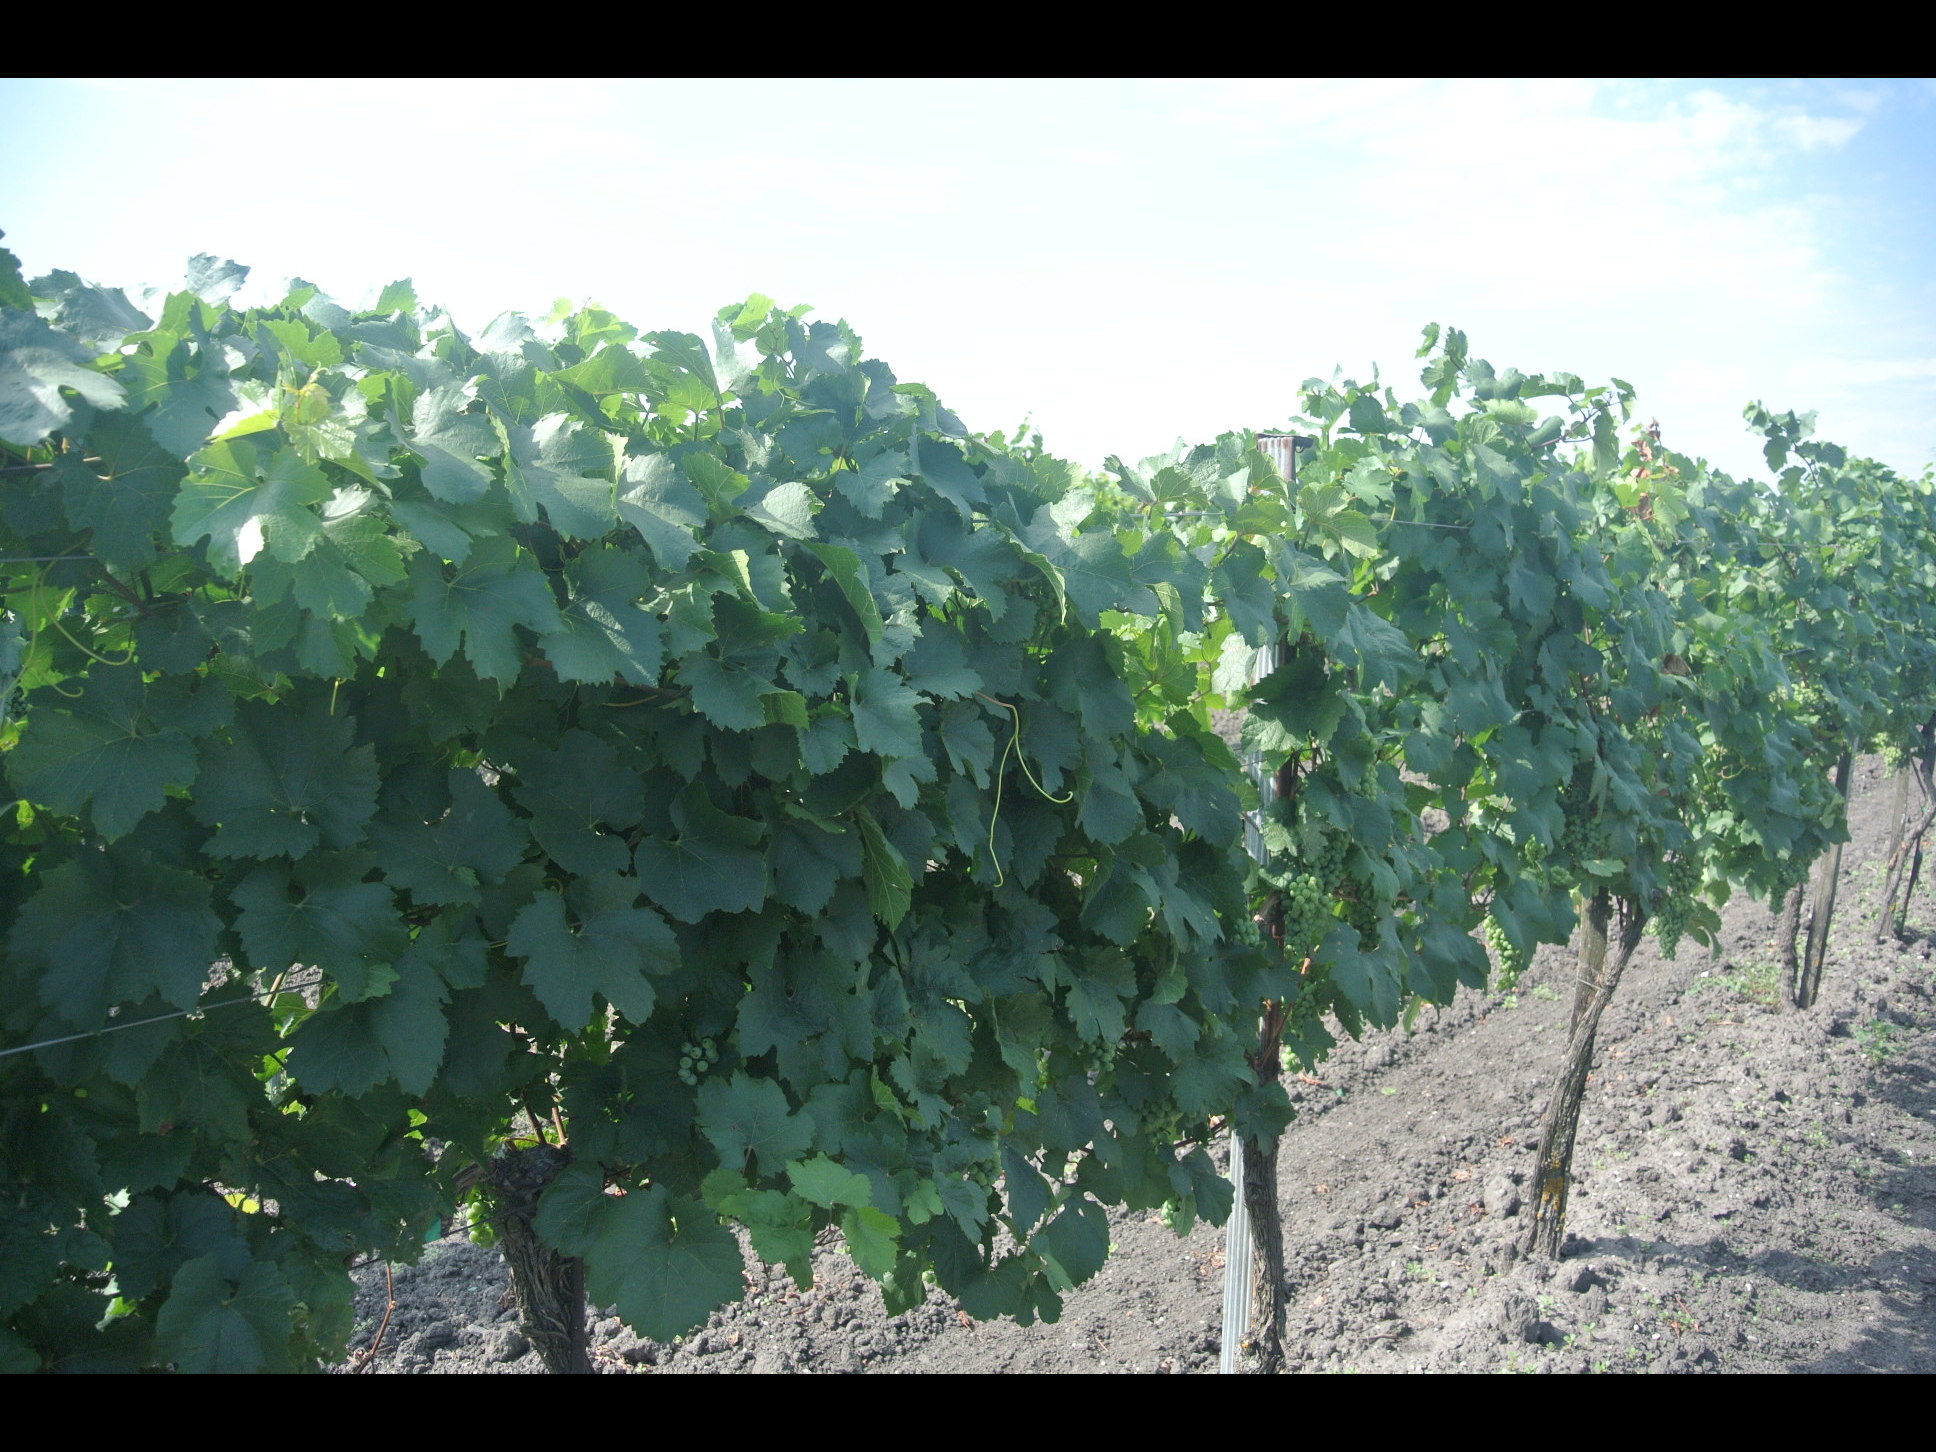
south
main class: Cropland
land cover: Vineyards
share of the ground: 25 - 50 %
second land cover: Other bare soil
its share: > 75 %
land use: Agriculture (excluding fallow land and kitchen gardens)
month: July
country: AT
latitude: 47.7234
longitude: 16.8181
